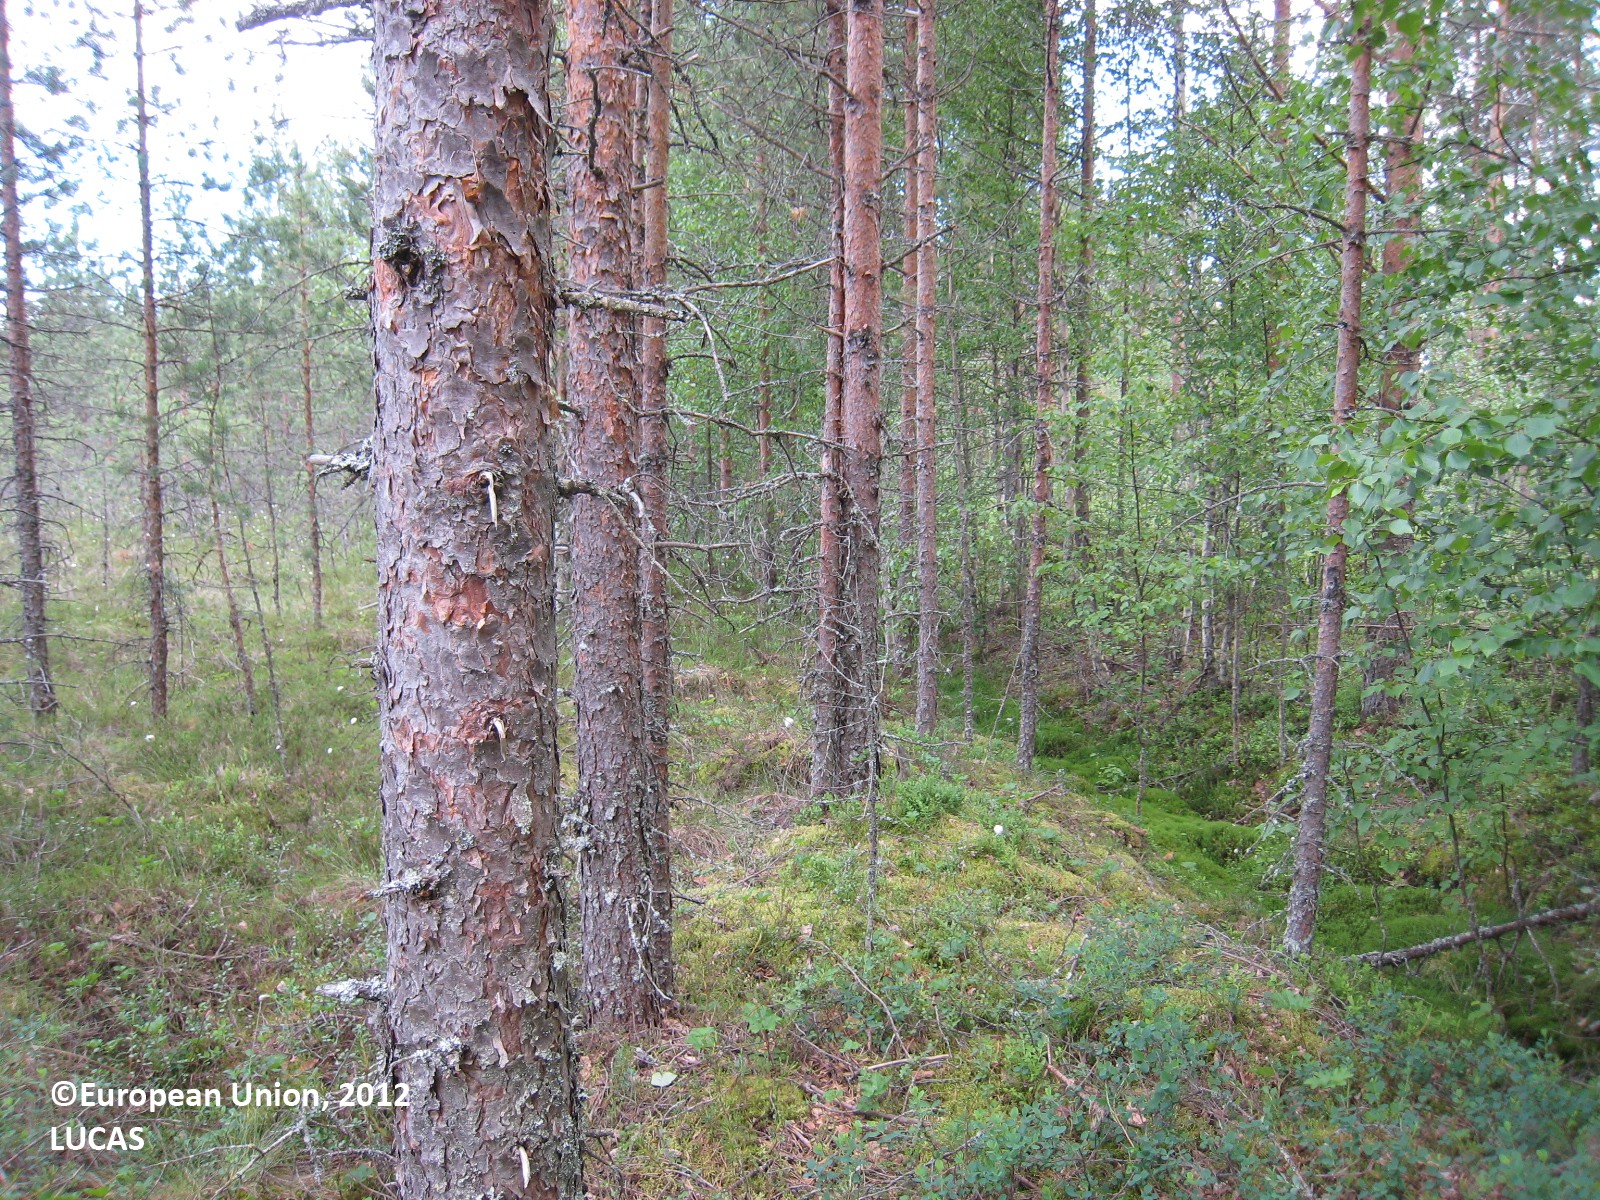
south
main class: Woodland
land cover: Pine dominated coniferous woodland
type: boreal forest
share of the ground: 50 - 75 %
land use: Forestry
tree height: > 5 m
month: June
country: FI
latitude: 61.9473
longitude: 26.2033
